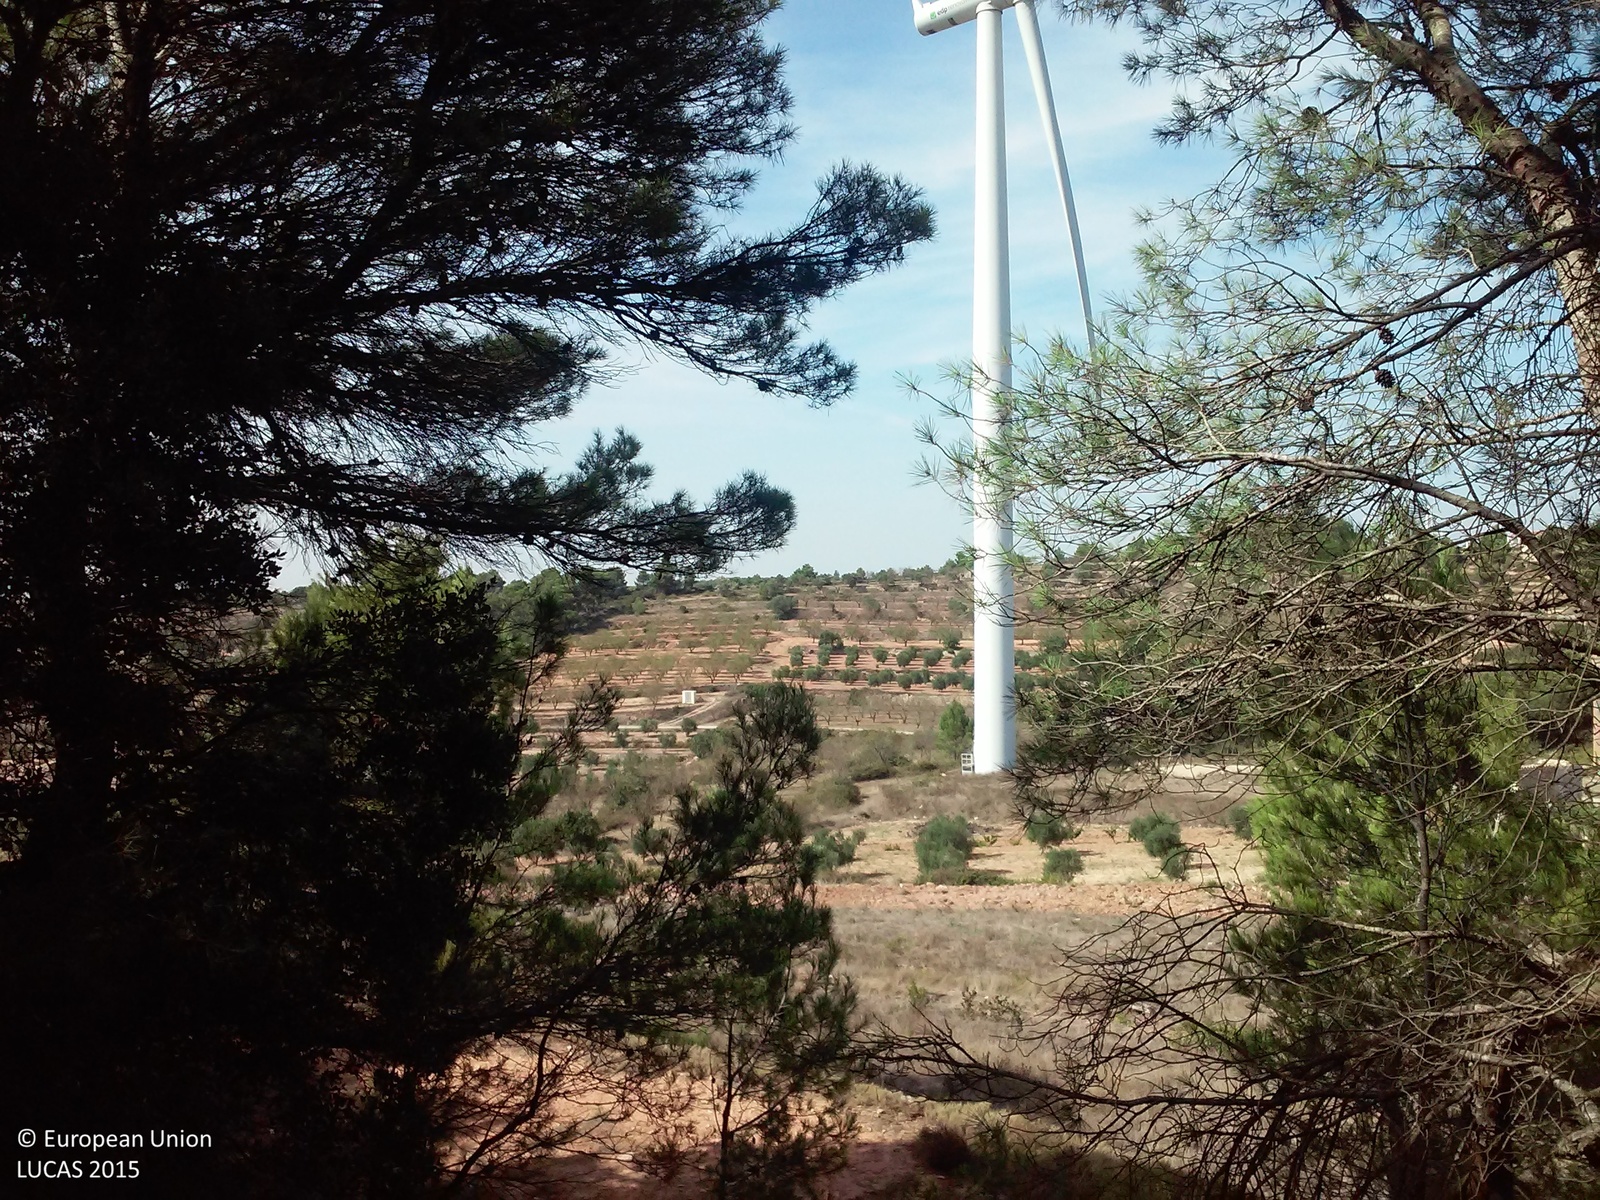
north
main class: Woodland
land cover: Pine dominated coniferous woodland
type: coniferous forest of the mediterranean region
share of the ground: 25 - 50 %
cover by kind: coniferous forest trees 30 %, shrubs 30 %, herbaceous plants 20 %, broadleaved forest trees 10 %, consolidated bare surface 10 %
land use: Semi-natural and natural areas not in use
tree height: < 5 m
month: August
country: ES
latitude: 41.1515
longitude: 0.4940
